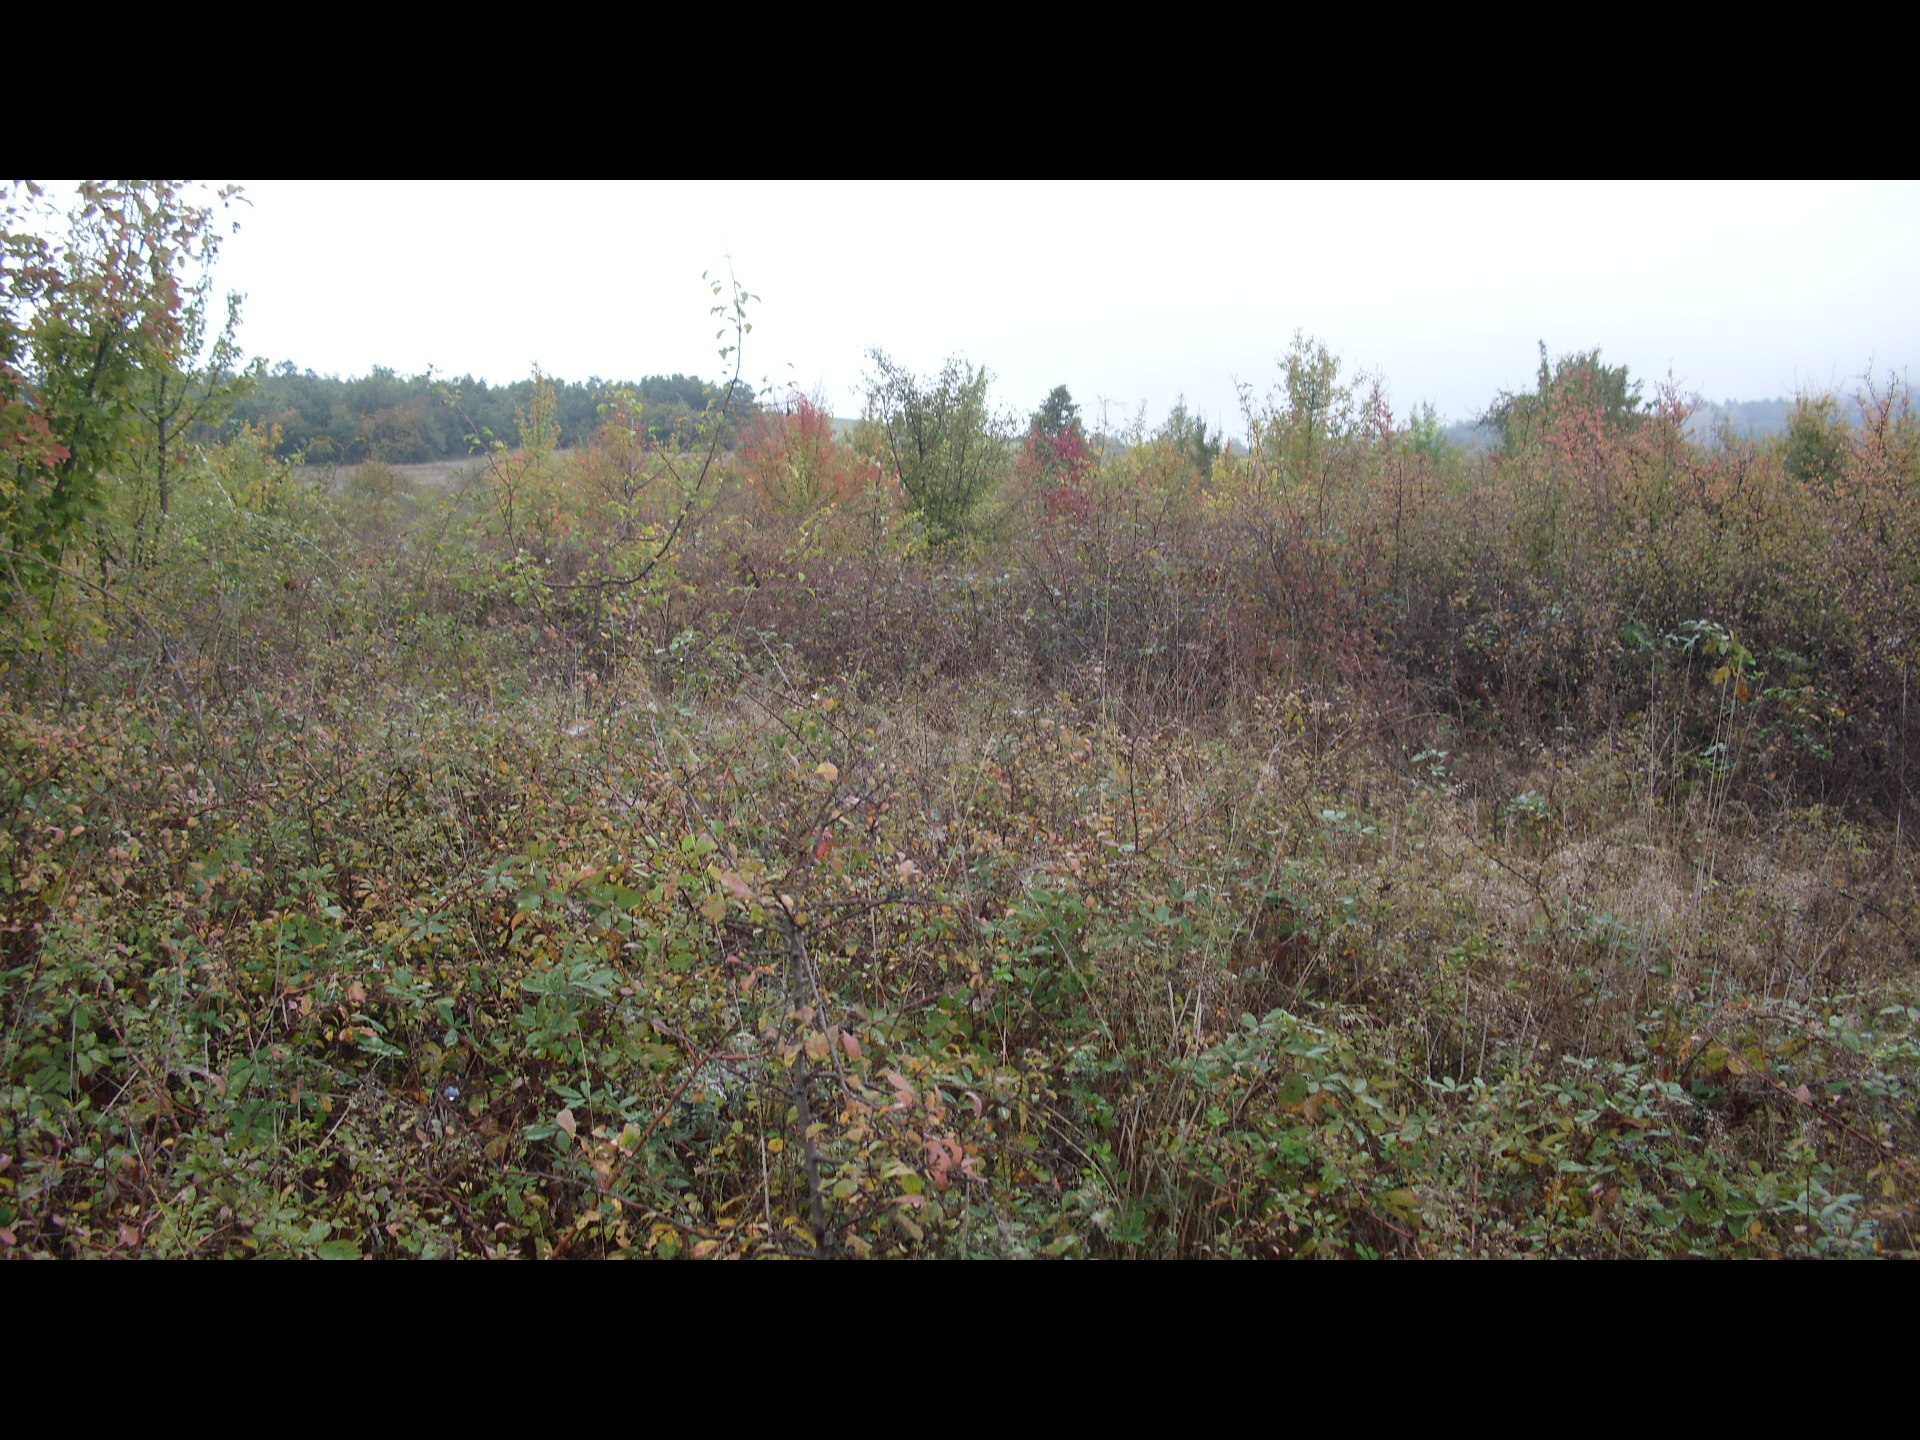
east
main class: Shrubland
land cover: Shrubland with sparse tree cover
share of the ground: > 75 %
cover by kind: shrubs 90 %, broadleaved forest trees 5 %, herbaceous plants 5 %
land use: Semi-natural and natural areas not in use
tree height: < 5 m
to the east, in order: Shrubland with sparse tree cover; Grassland without tree/shrub cover; Tracks; Grassland with sparse tree/shrub cover
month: October
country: BG
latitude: 43.5429
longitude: 22.7444
